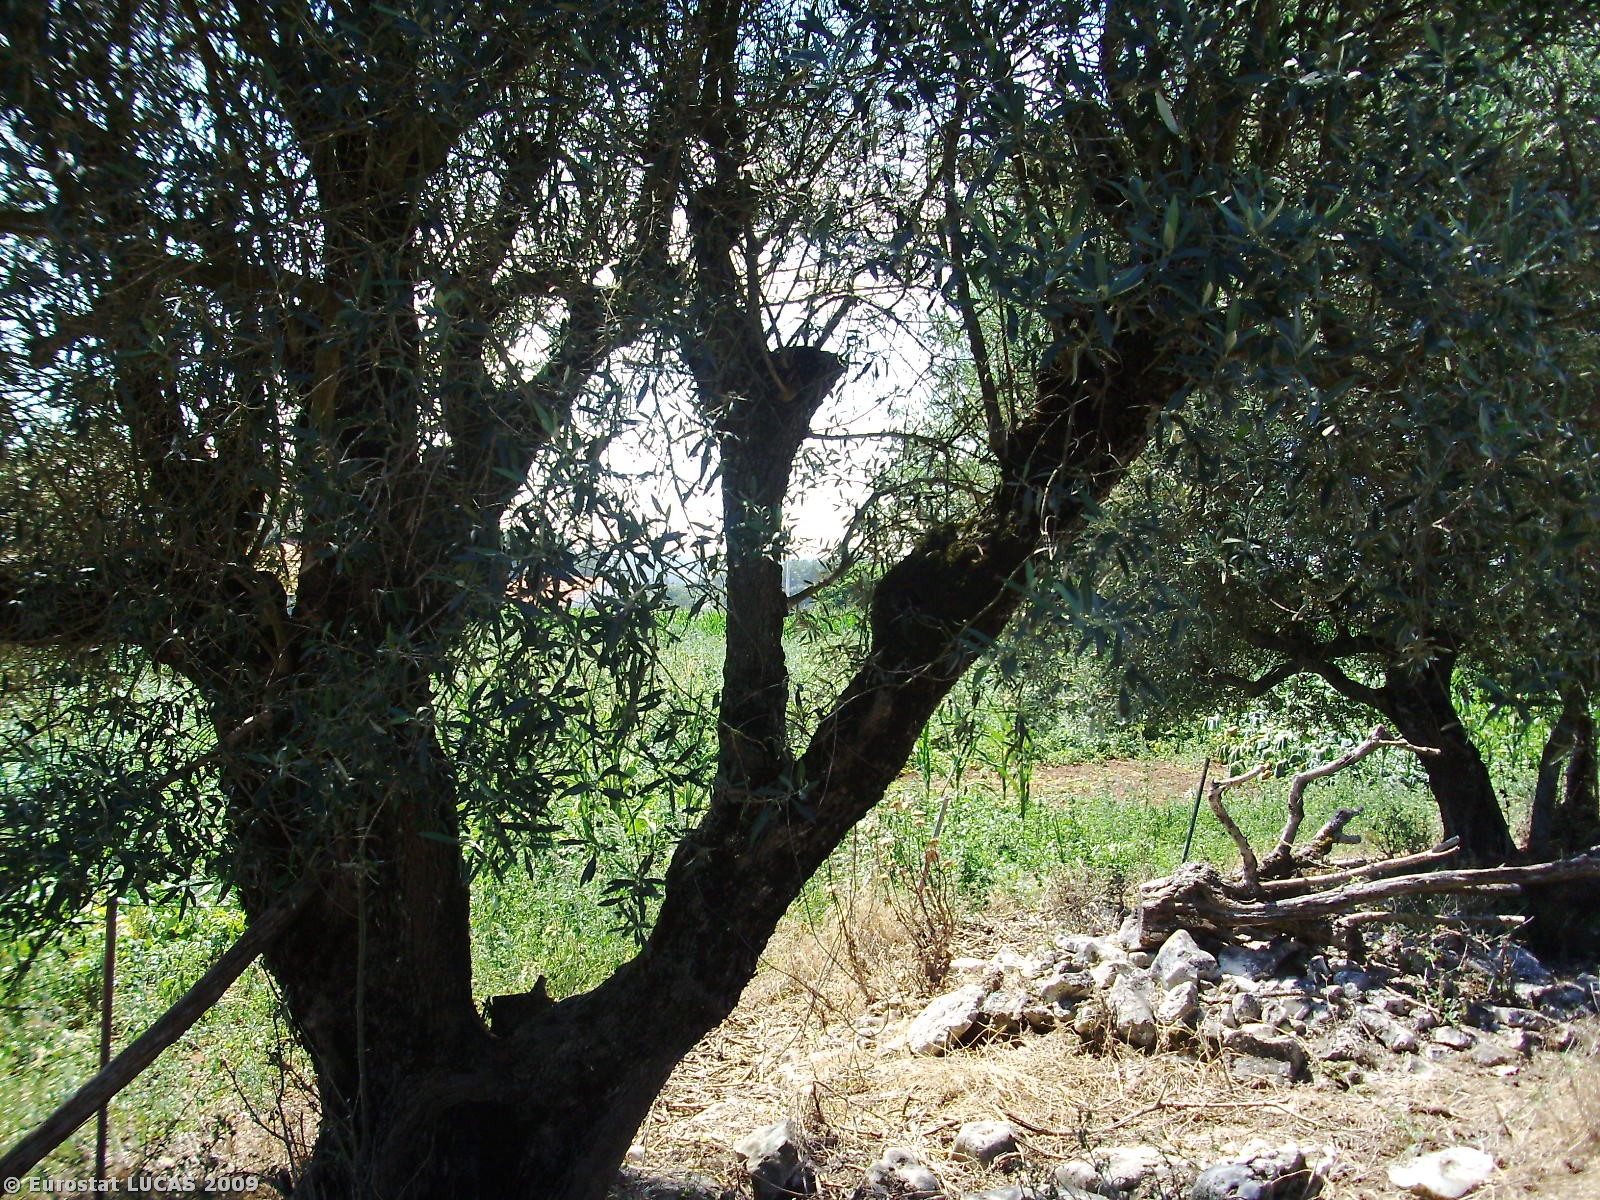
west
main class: Cropland
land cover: Olive groves
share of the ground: 10 - 25 %
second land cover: Spontaneously vegetated surfaces
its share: 25 - 50 %
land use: Agriculture (excluding fallow land and kitchen gardens)
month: July
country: PT
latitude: 39.4797
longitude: -8.9294
